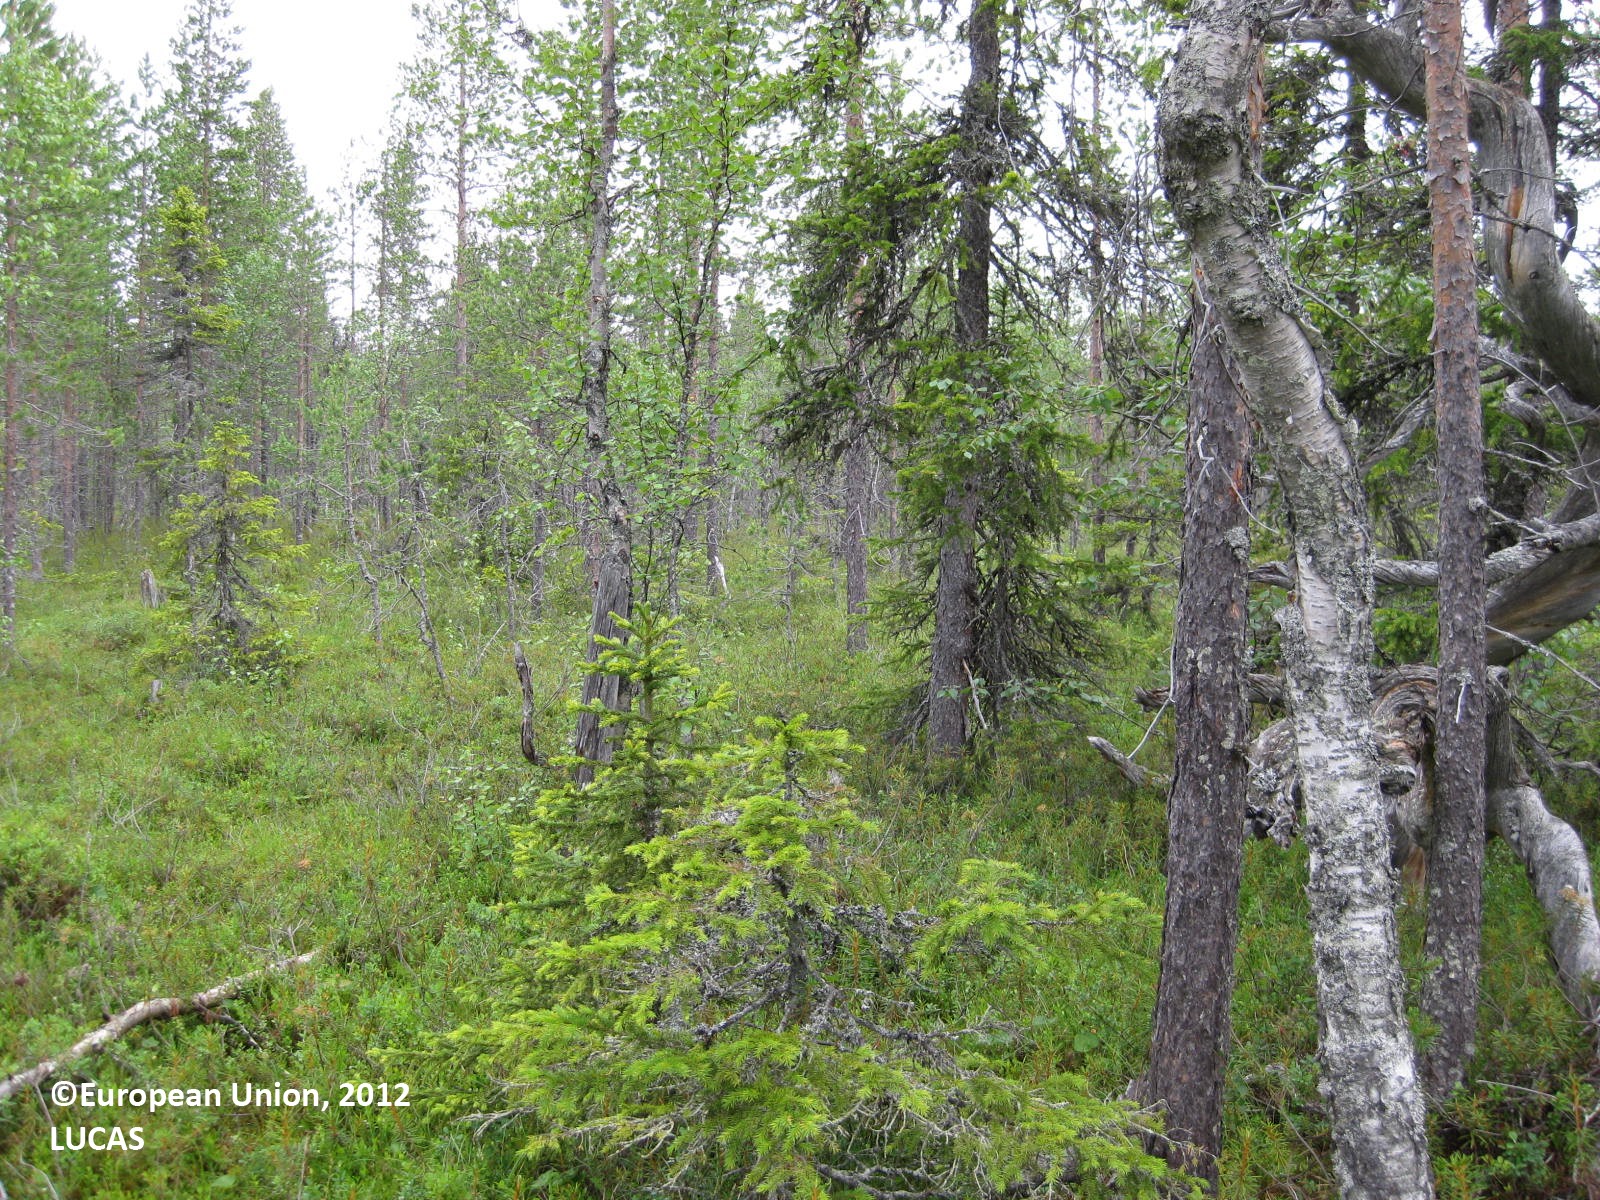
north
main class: Woodland
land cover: Pine dominated coniferous woodland
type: boreal forest
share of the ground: 50 - 75 %
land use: Forestry
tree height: > 5 m
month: July
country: FI
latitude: 65.8597
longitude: 29.5891
